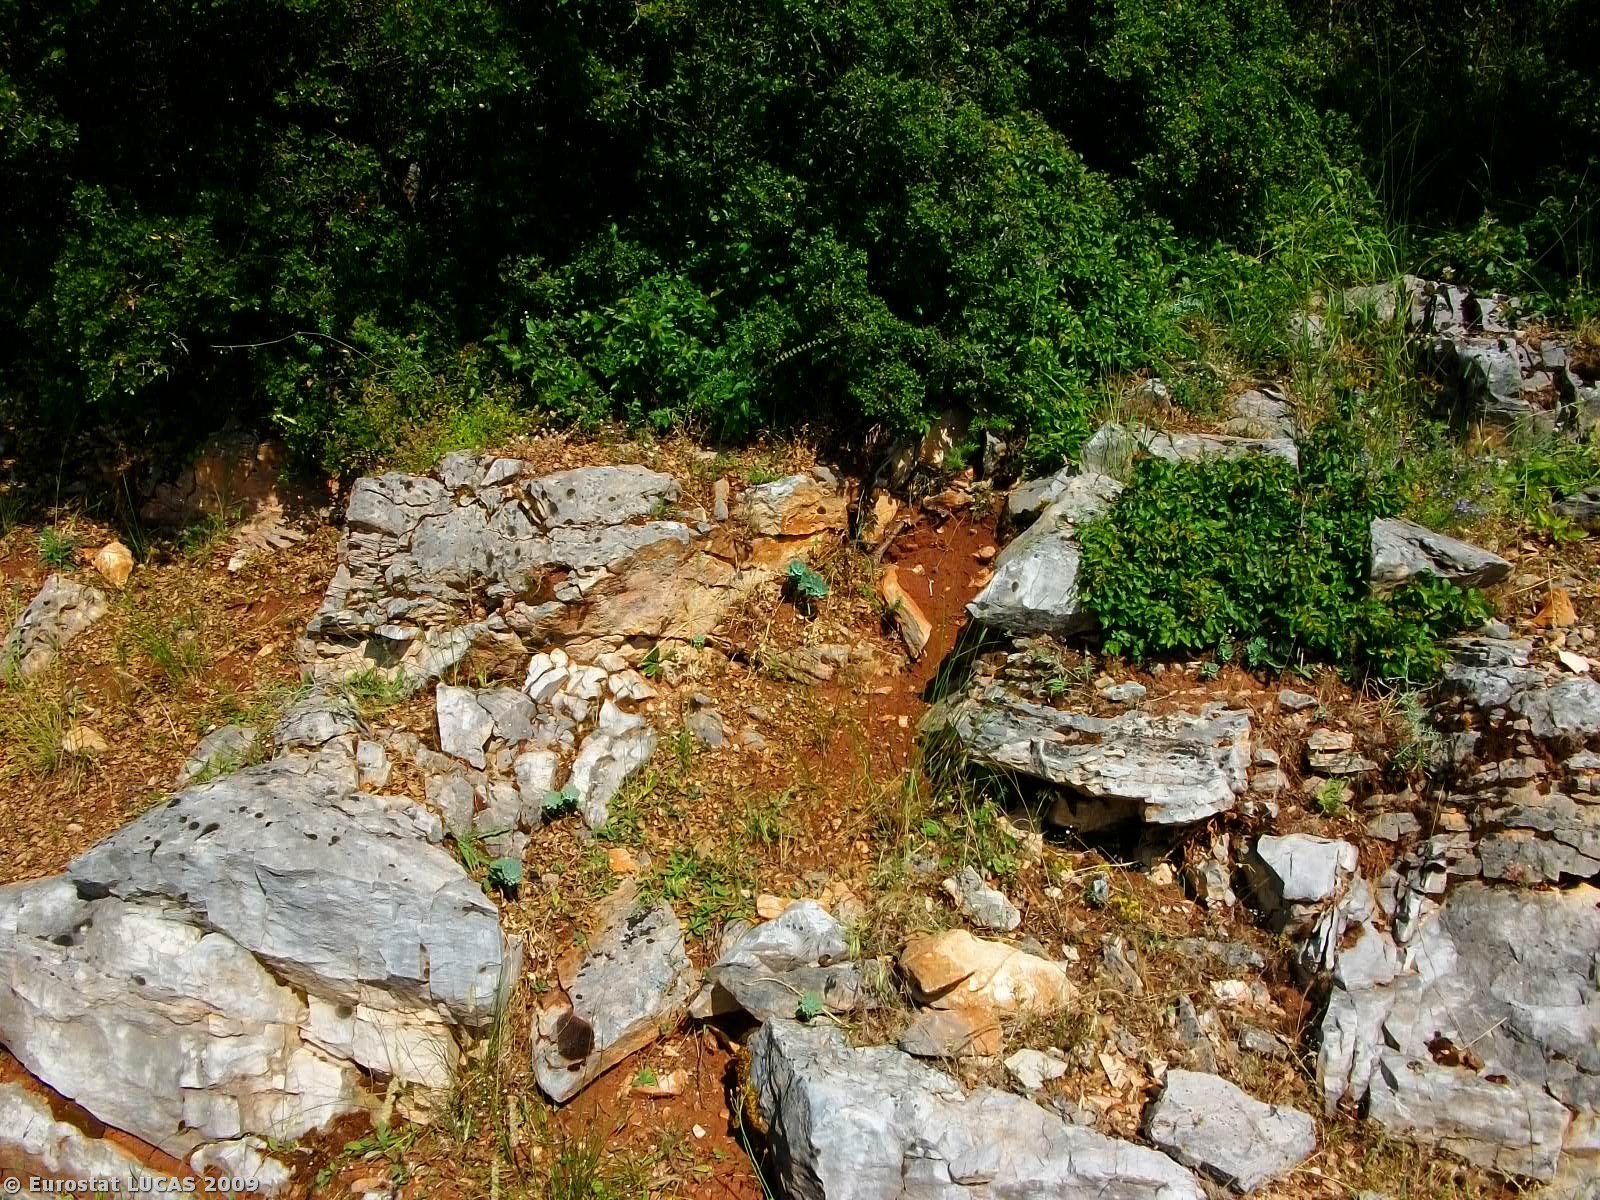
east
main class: Shrubland
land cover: Shrubland with sparse tree cover
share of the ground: > 75 %
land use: Unused
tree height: < 5 m
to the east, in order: Shrubland with sparse tree cover
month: June
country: GR
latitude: 41.1760
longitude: 24.4218
